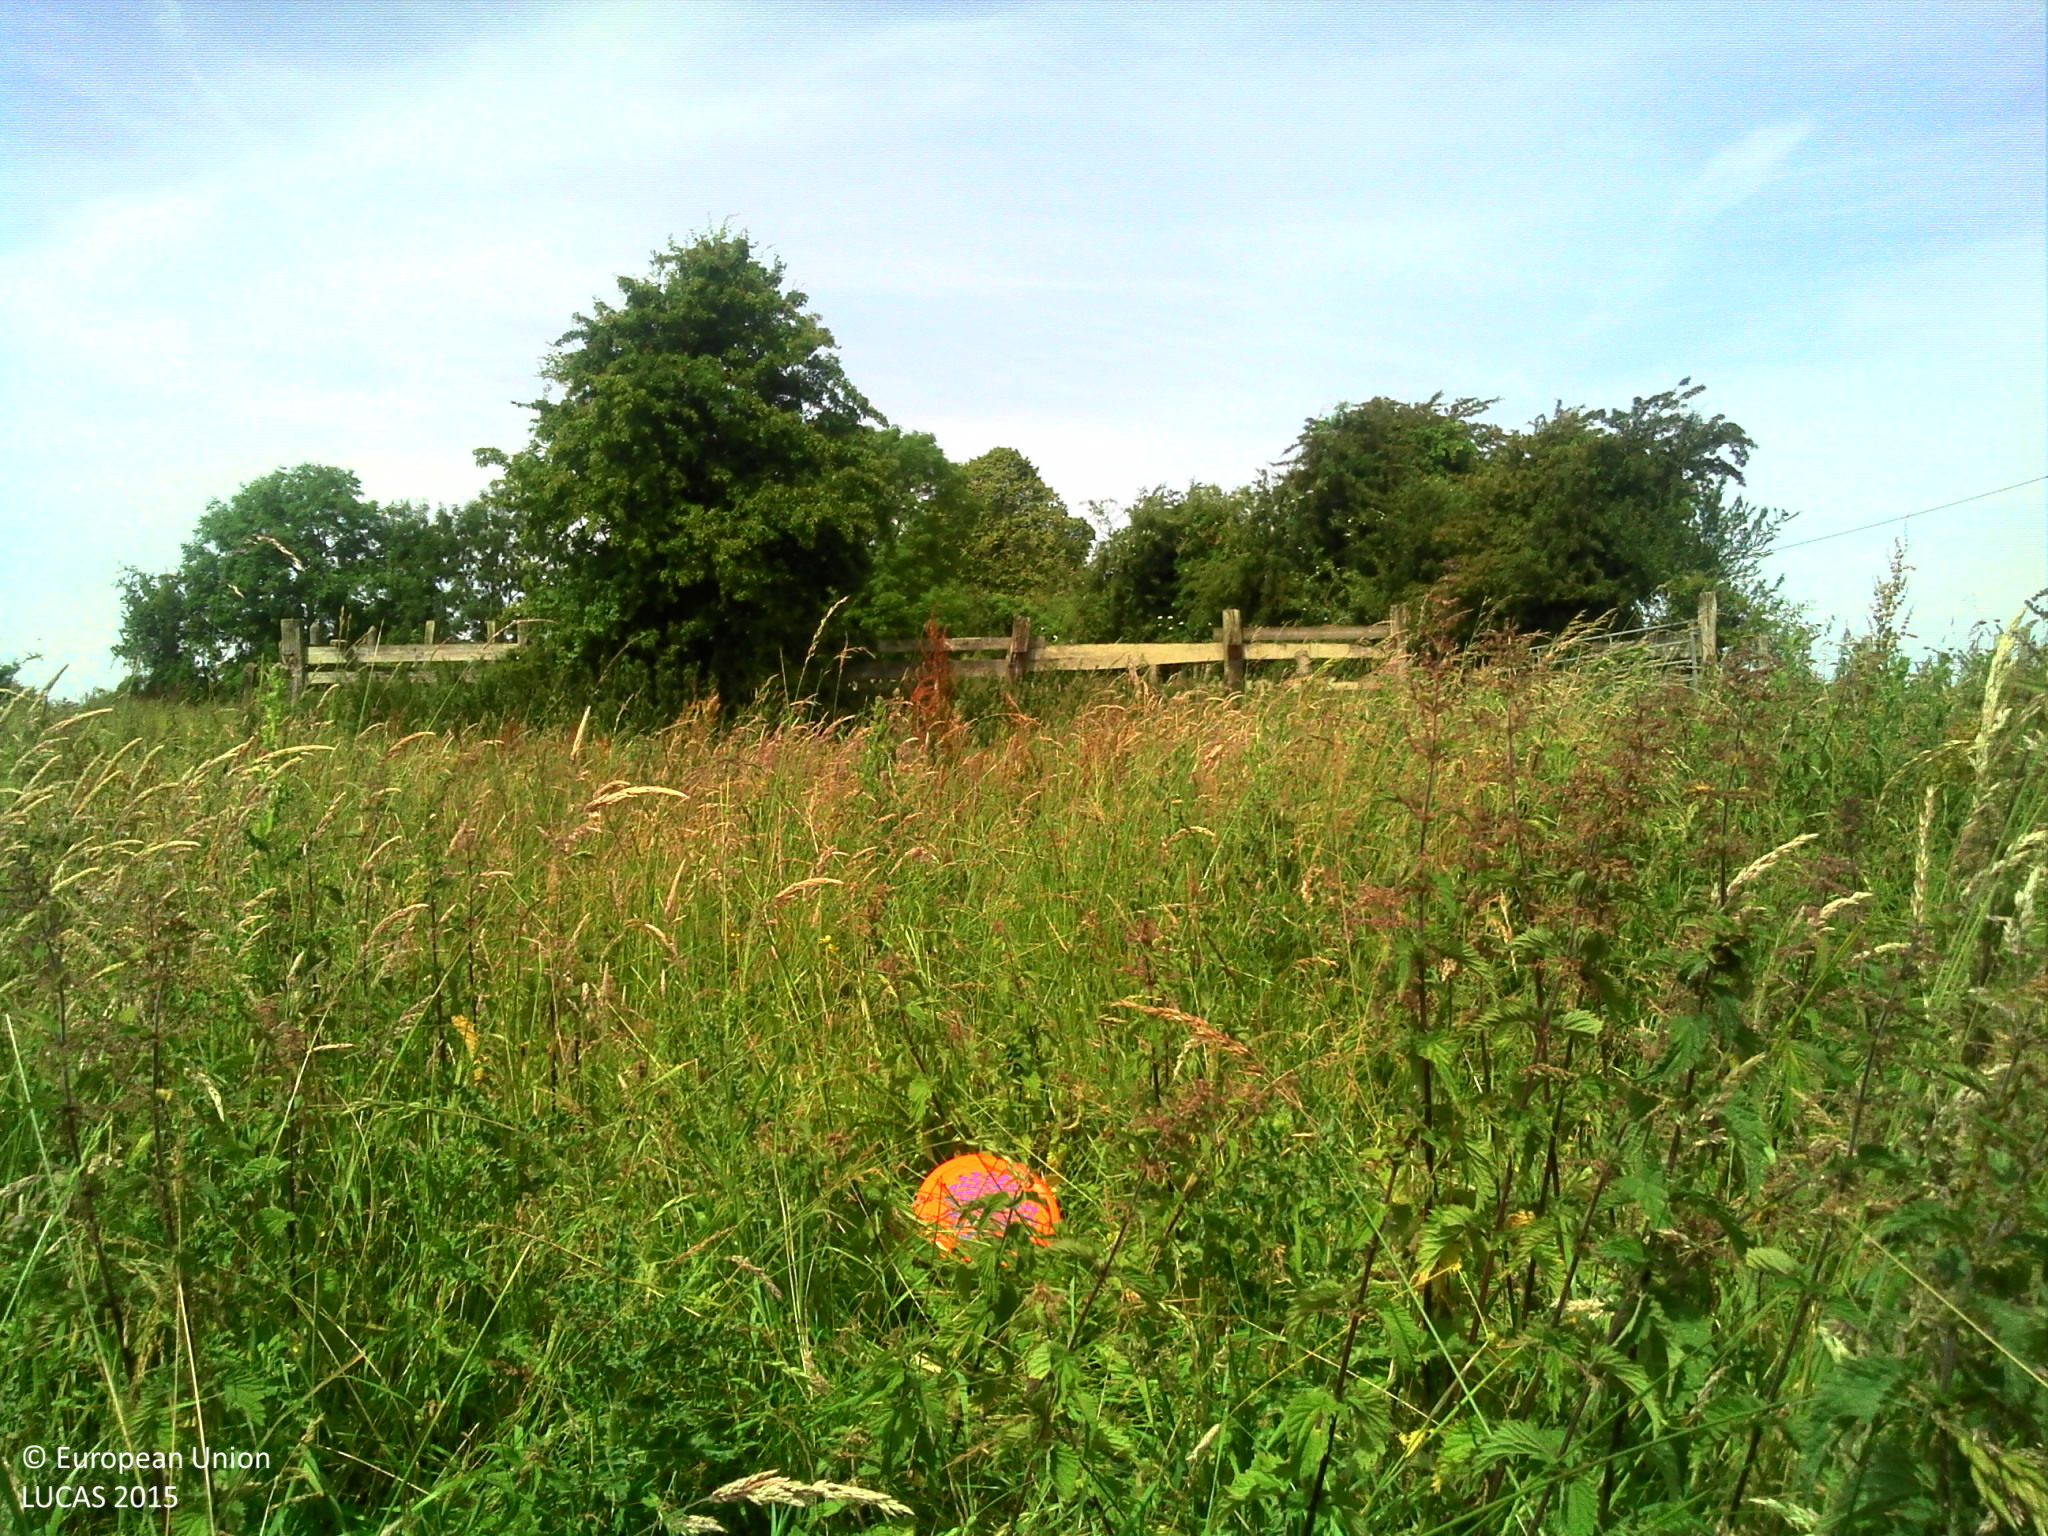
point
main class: Grassland
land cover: Grassland without tree/shrub cover
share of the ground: > 75 %
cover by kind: herbaceous plants 100 %
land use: Agriculture (excluding fallow land and kitchen gardens)
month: June
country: FR
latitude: 48.8161
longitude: -0.2331
